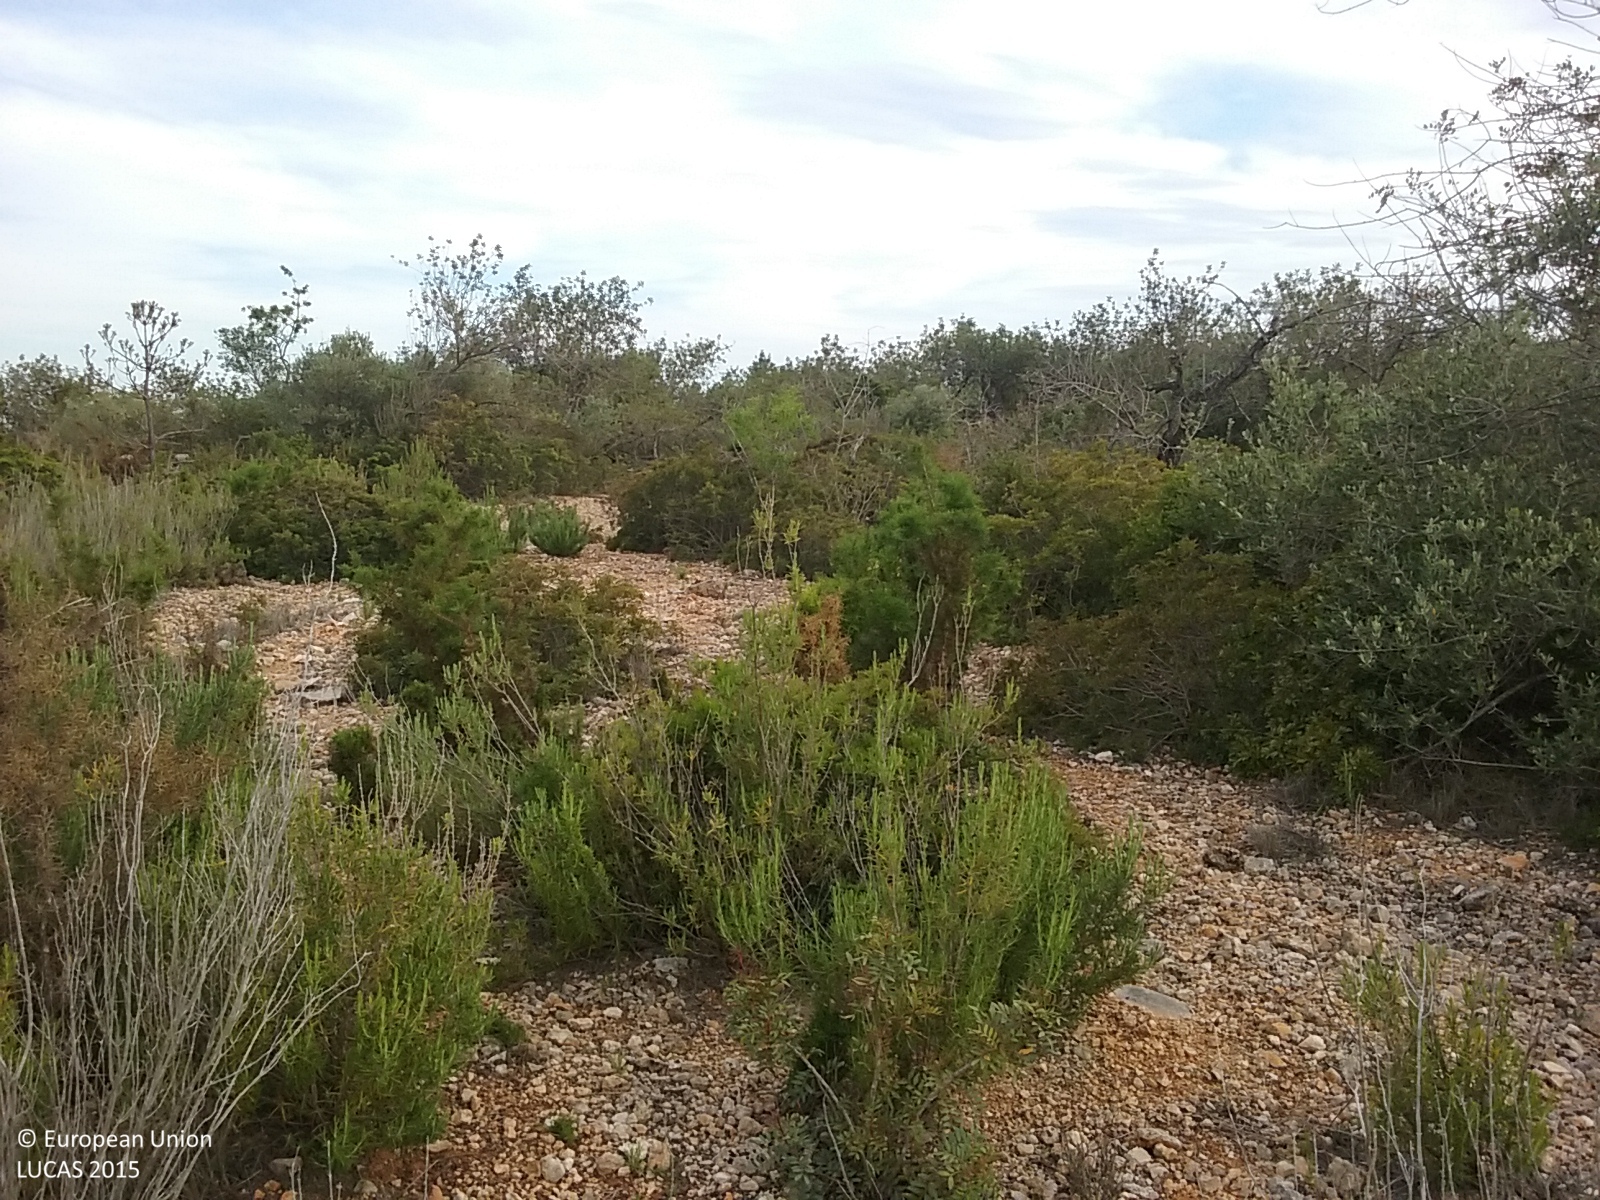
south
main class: Shrubland
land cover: Shrubland with sparse tree cover
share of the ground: 50 - 75 %
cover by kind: shrubs 70 %, unconsolidated bare surface 25 %, broadleaved forest trees 5 %
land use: Abandoned areas
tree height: < 5 m
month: May
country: ES
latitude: 40.2222
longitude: 0.1144
